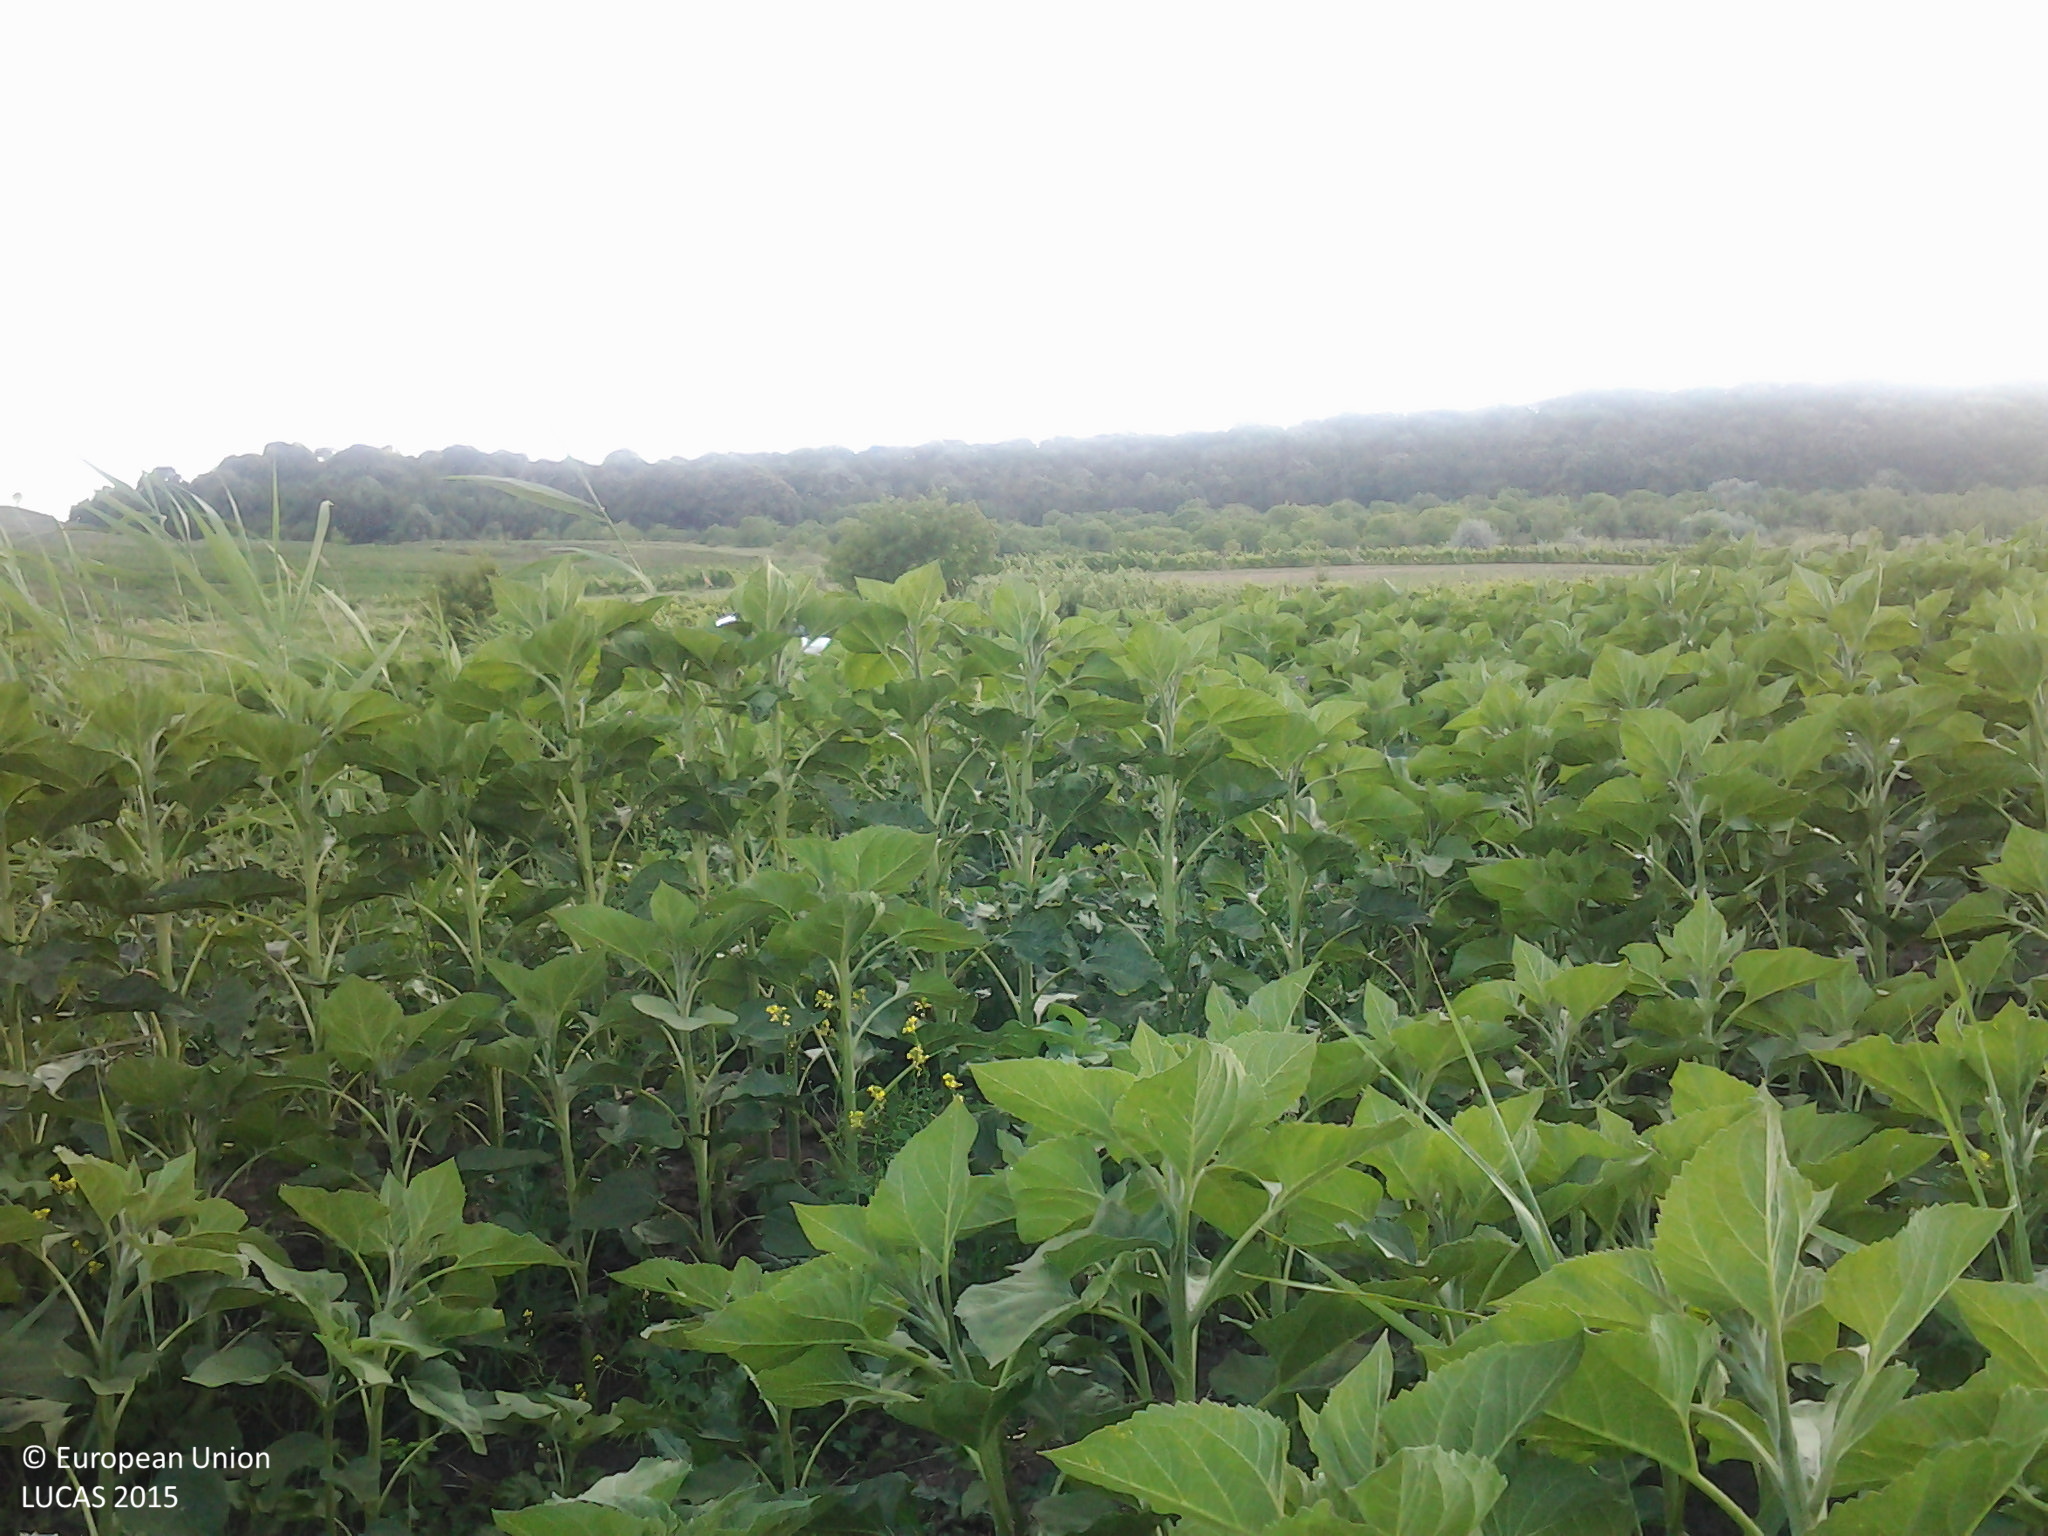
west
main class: Cropland
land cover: Sunflower
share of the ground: > 75 %
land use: Agriculture (excluding fallow land and kitchen gardens)
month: June
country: RO
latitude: 46.9083
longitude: 27.4556
